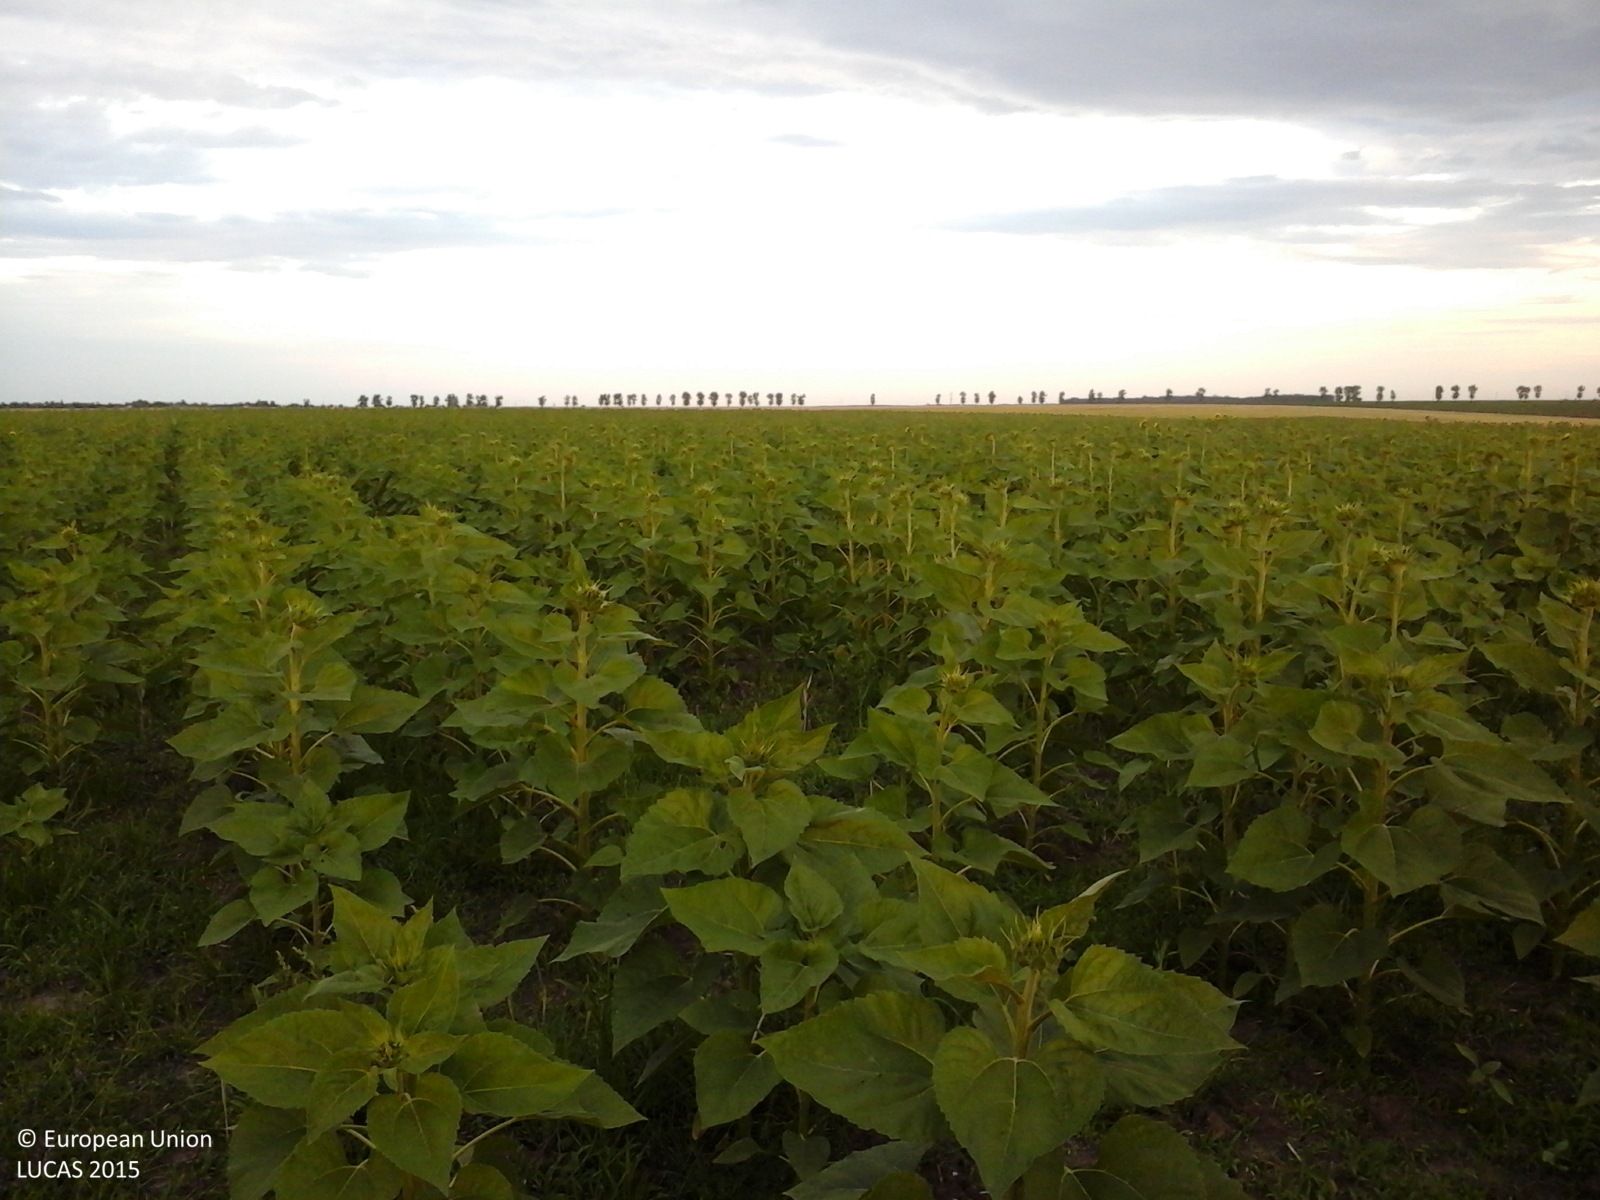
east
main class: Cropland
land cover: Sunflower
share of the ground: 50 - 75 %
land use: Agriculture (excluding fallow land and kitchen gardens)
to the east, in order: Sunflower
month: July
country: RO
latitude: 44.3317
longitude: 24.8880
